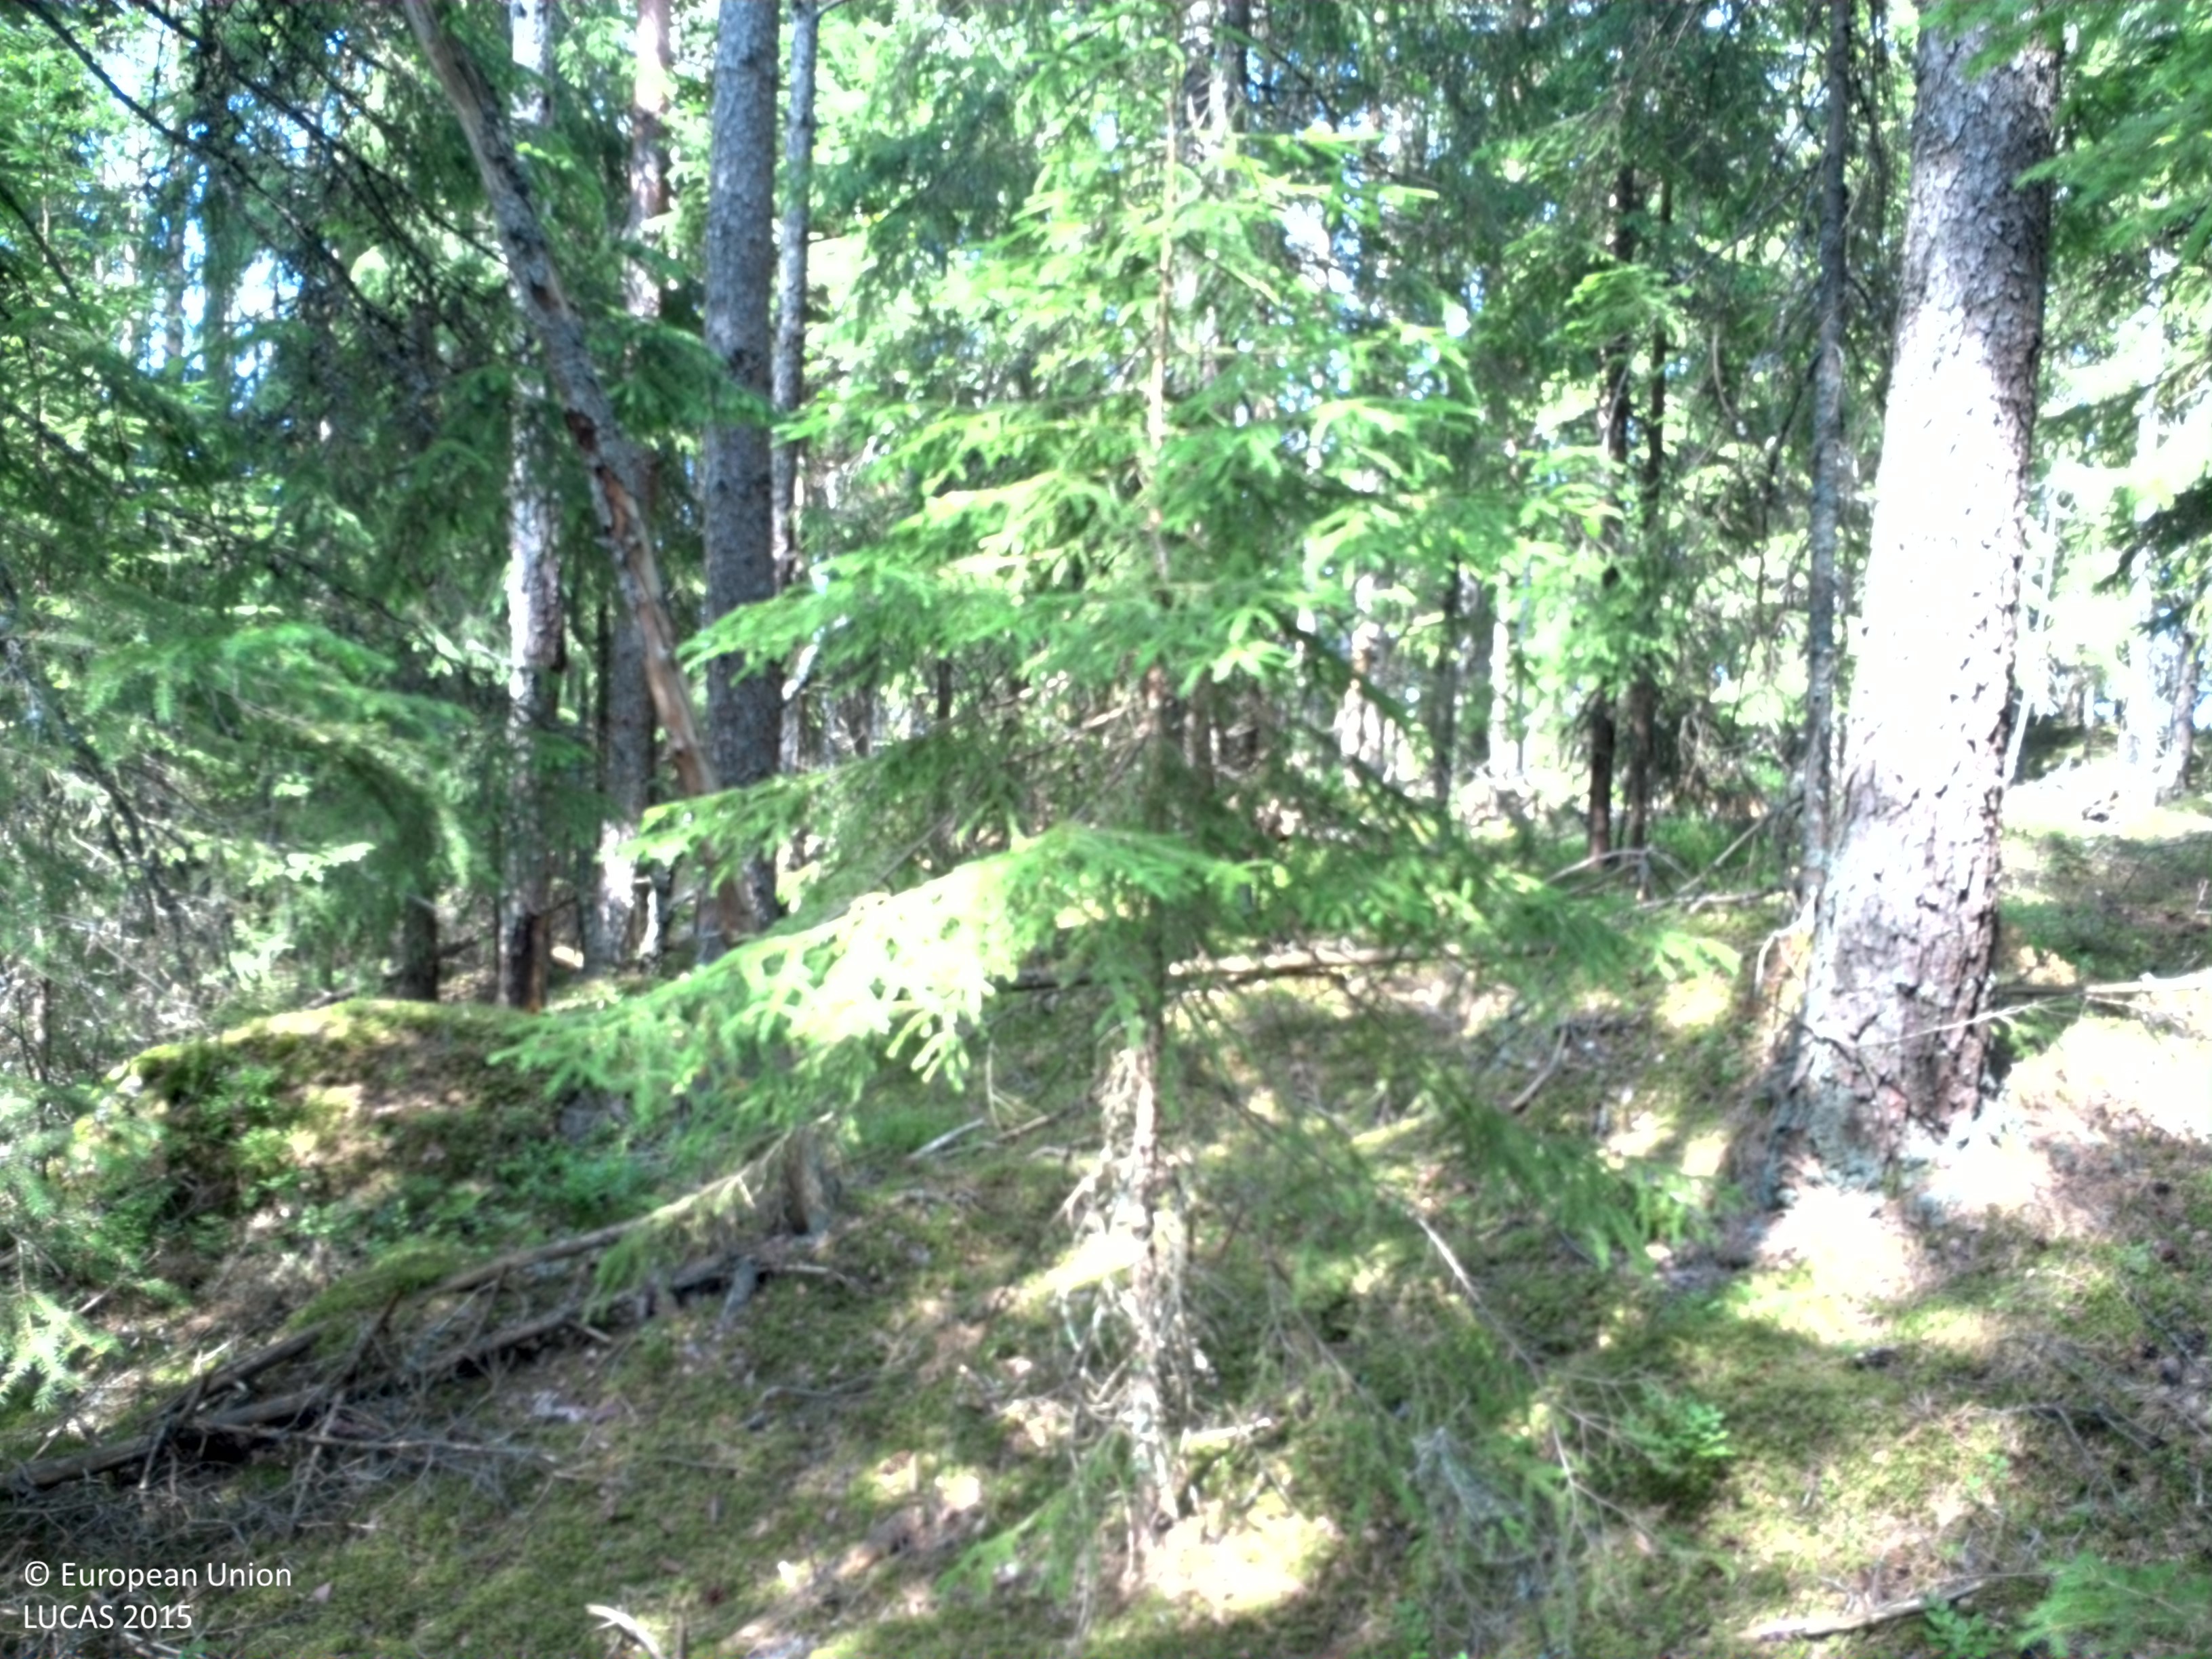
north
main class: Woodland
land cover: Pine dominated coniferous woodland
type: boreal forest
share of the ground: 50 - 75 %
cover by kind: coniferous forest trees 75 %, lichens and mosses 20 %, shrubs 5 %
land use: Forestry
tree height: > 5 m
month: July
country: SE
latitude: 57.6578
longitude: 13.9337
